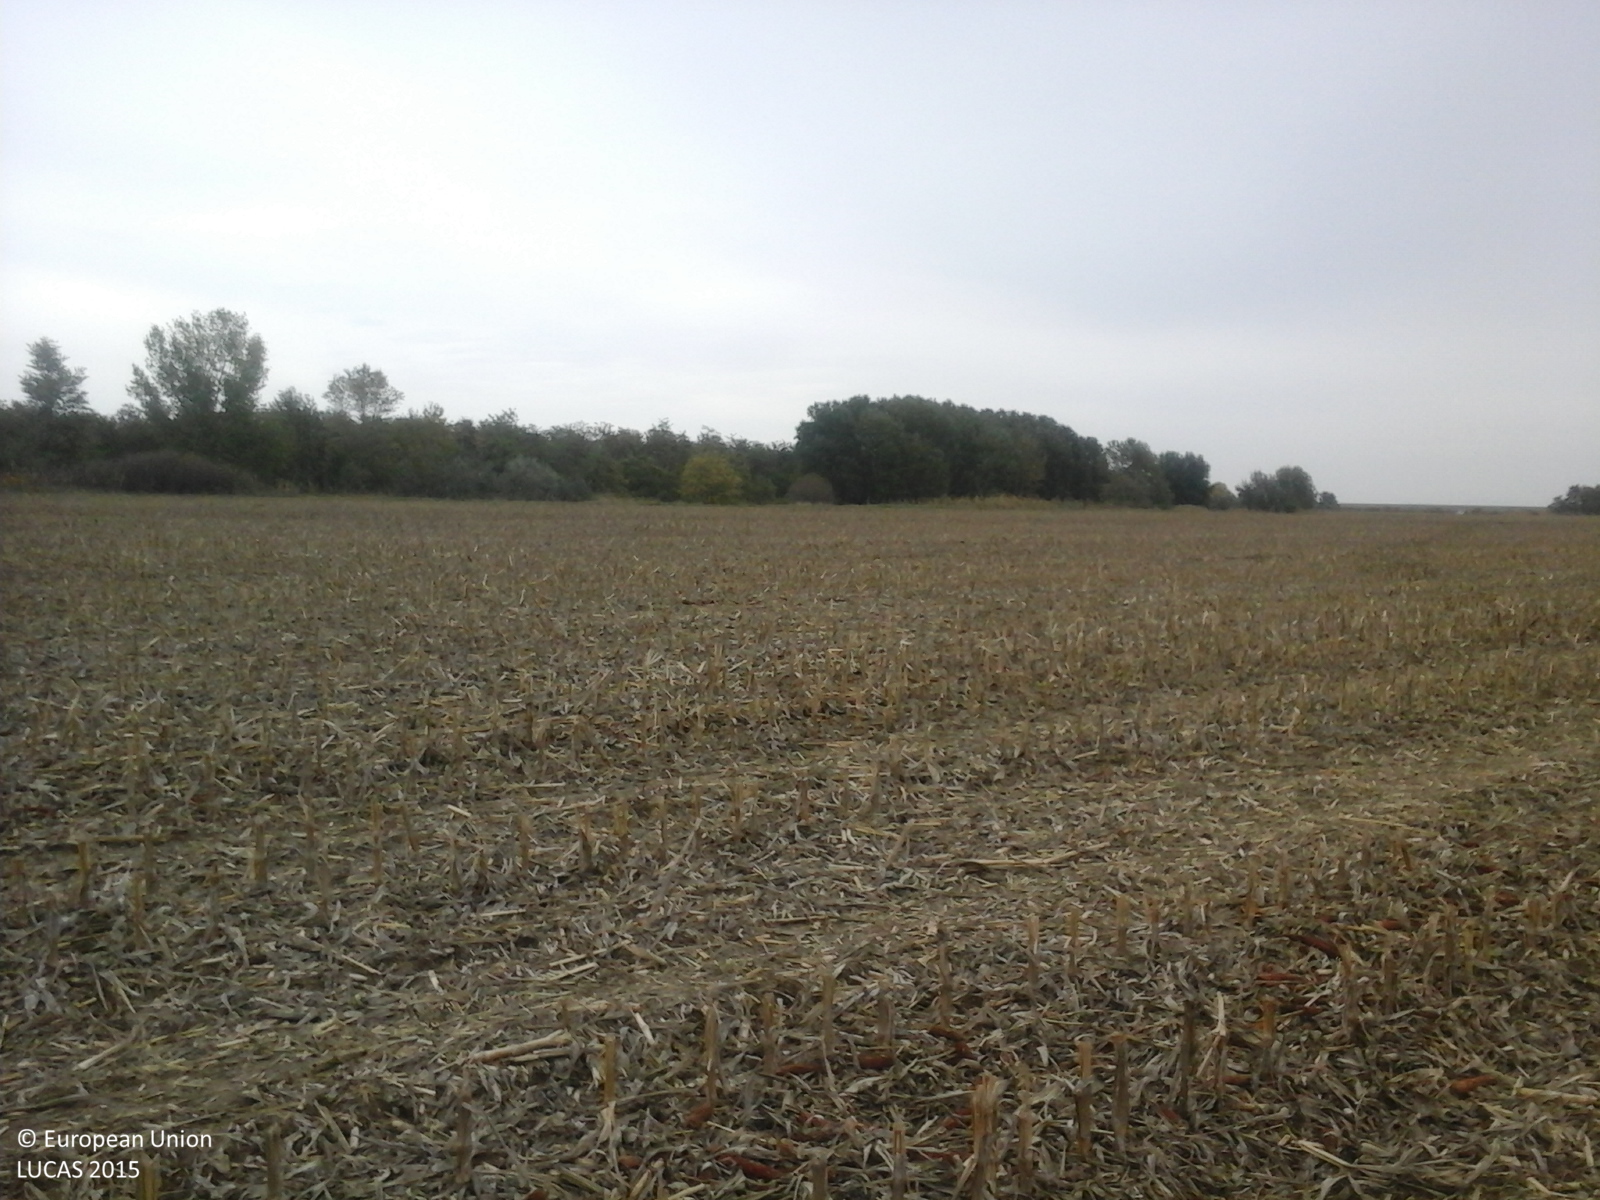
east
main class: Cropland
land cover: Maize
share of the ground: 50 - 75 %
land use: Agriculture (excluding fallow land and kitchen gardens)
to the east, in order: Maize
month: October
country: RO
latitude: 44.8829
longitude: 26.3329
